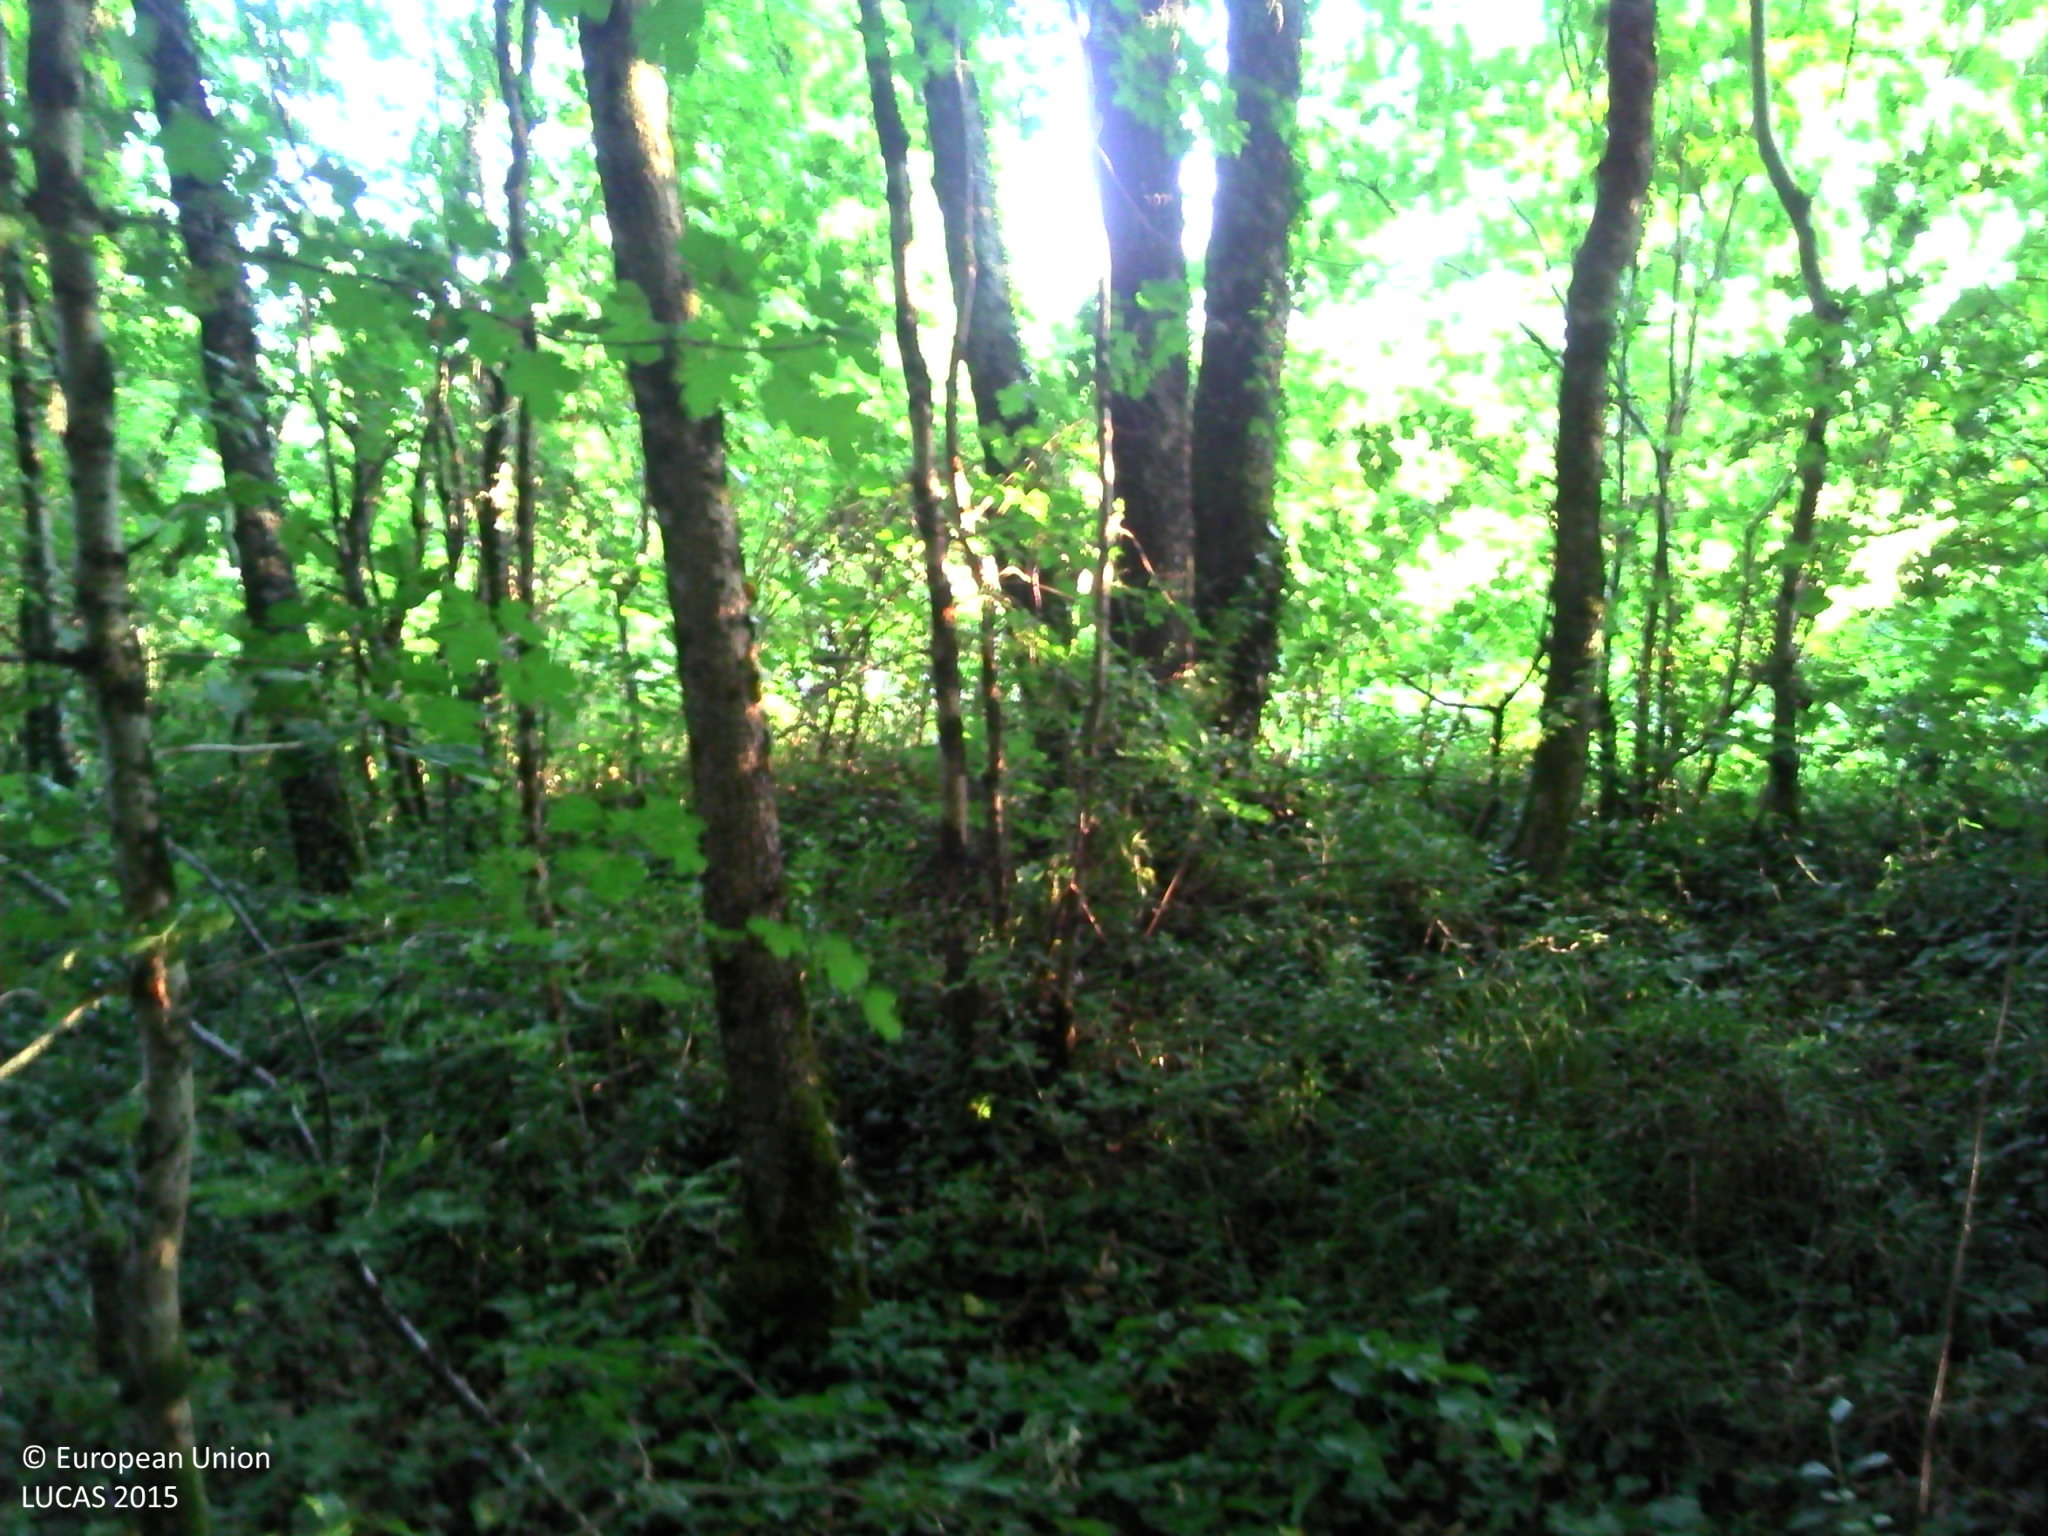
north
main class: Woodland
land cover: Broadleaved woodland
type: mesophytic deciduous forest
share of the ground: > 75 %
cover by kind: broadleaved forest trees 85 %, shrubs 10 %, herbaceous plants 5 %
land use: Forestry
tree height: > 5 m
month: June
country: FR
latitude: 46.6781
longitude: 0.5830
